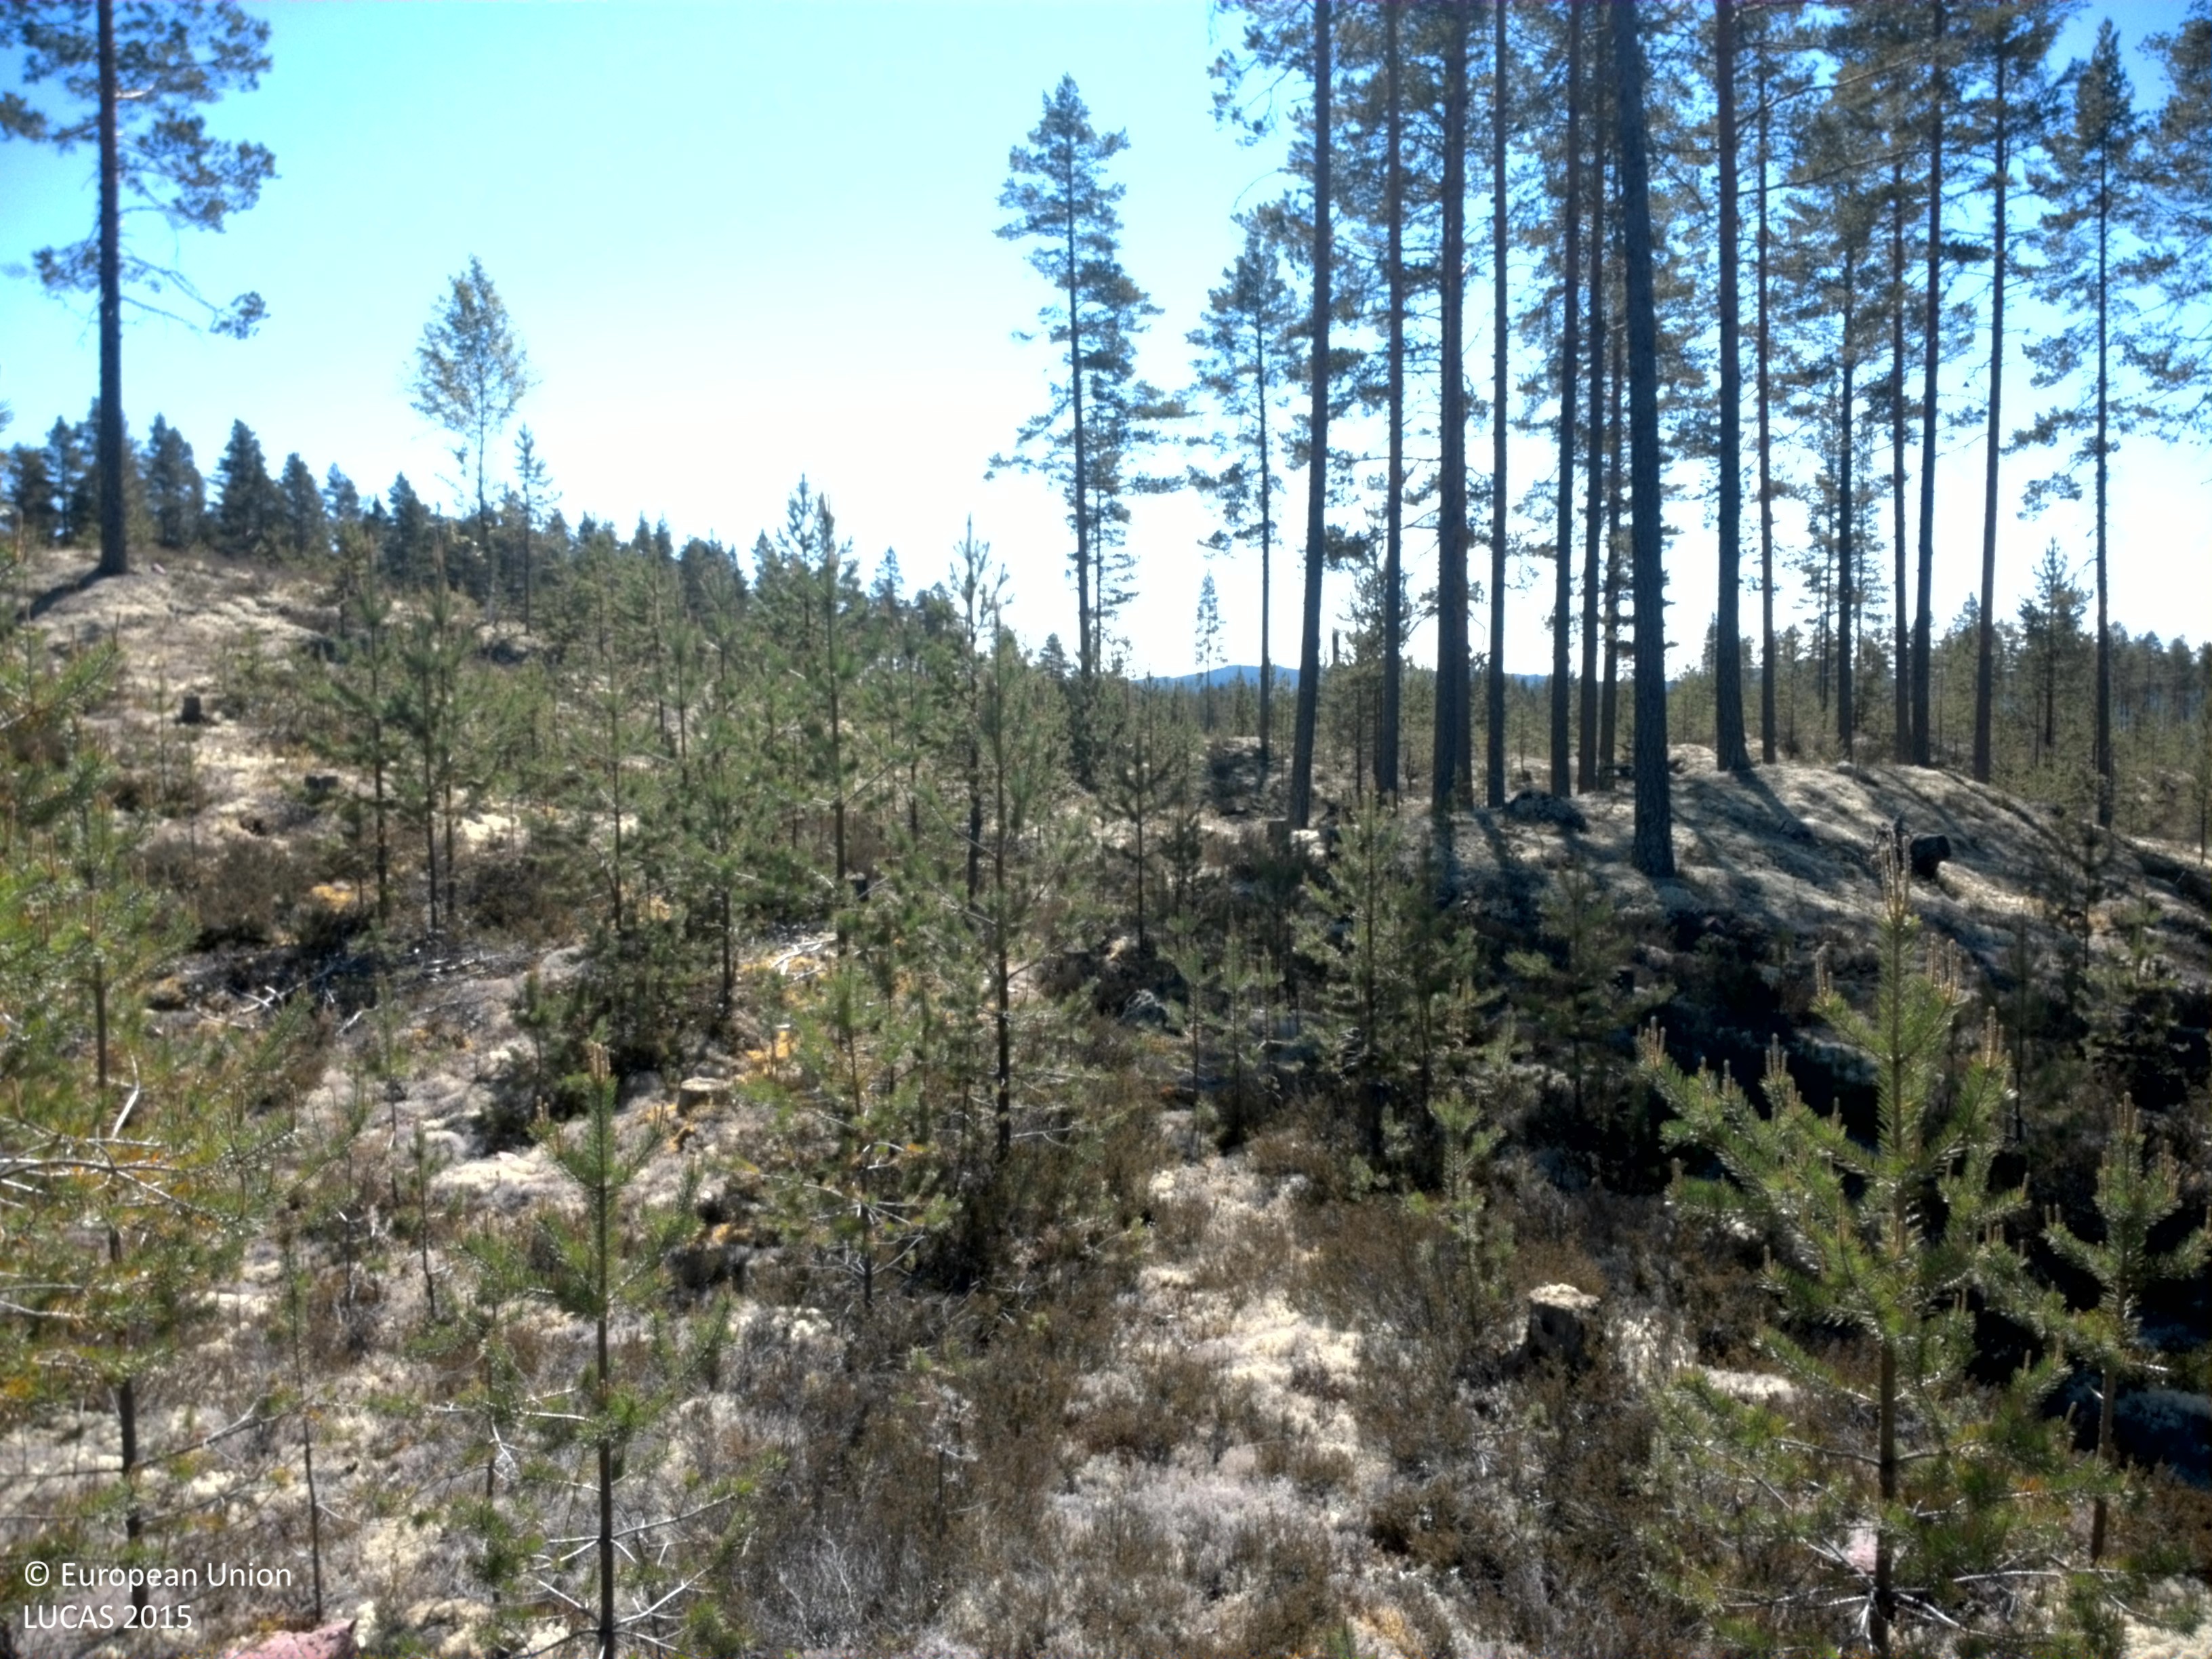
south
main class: Woodland
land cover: Pine dominated coniferous woodland
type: boreal forest
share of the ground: 25 - 50 %
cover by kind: coniferous forest trees 45 %, lichens and mosses 25 %, shrubs 15 %, consolidated bare surface 10 %, herbaceous plants 5 %
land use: Forestry
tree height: < 5 m
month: June
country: SE
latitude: 61.3597
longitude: 13.6343
